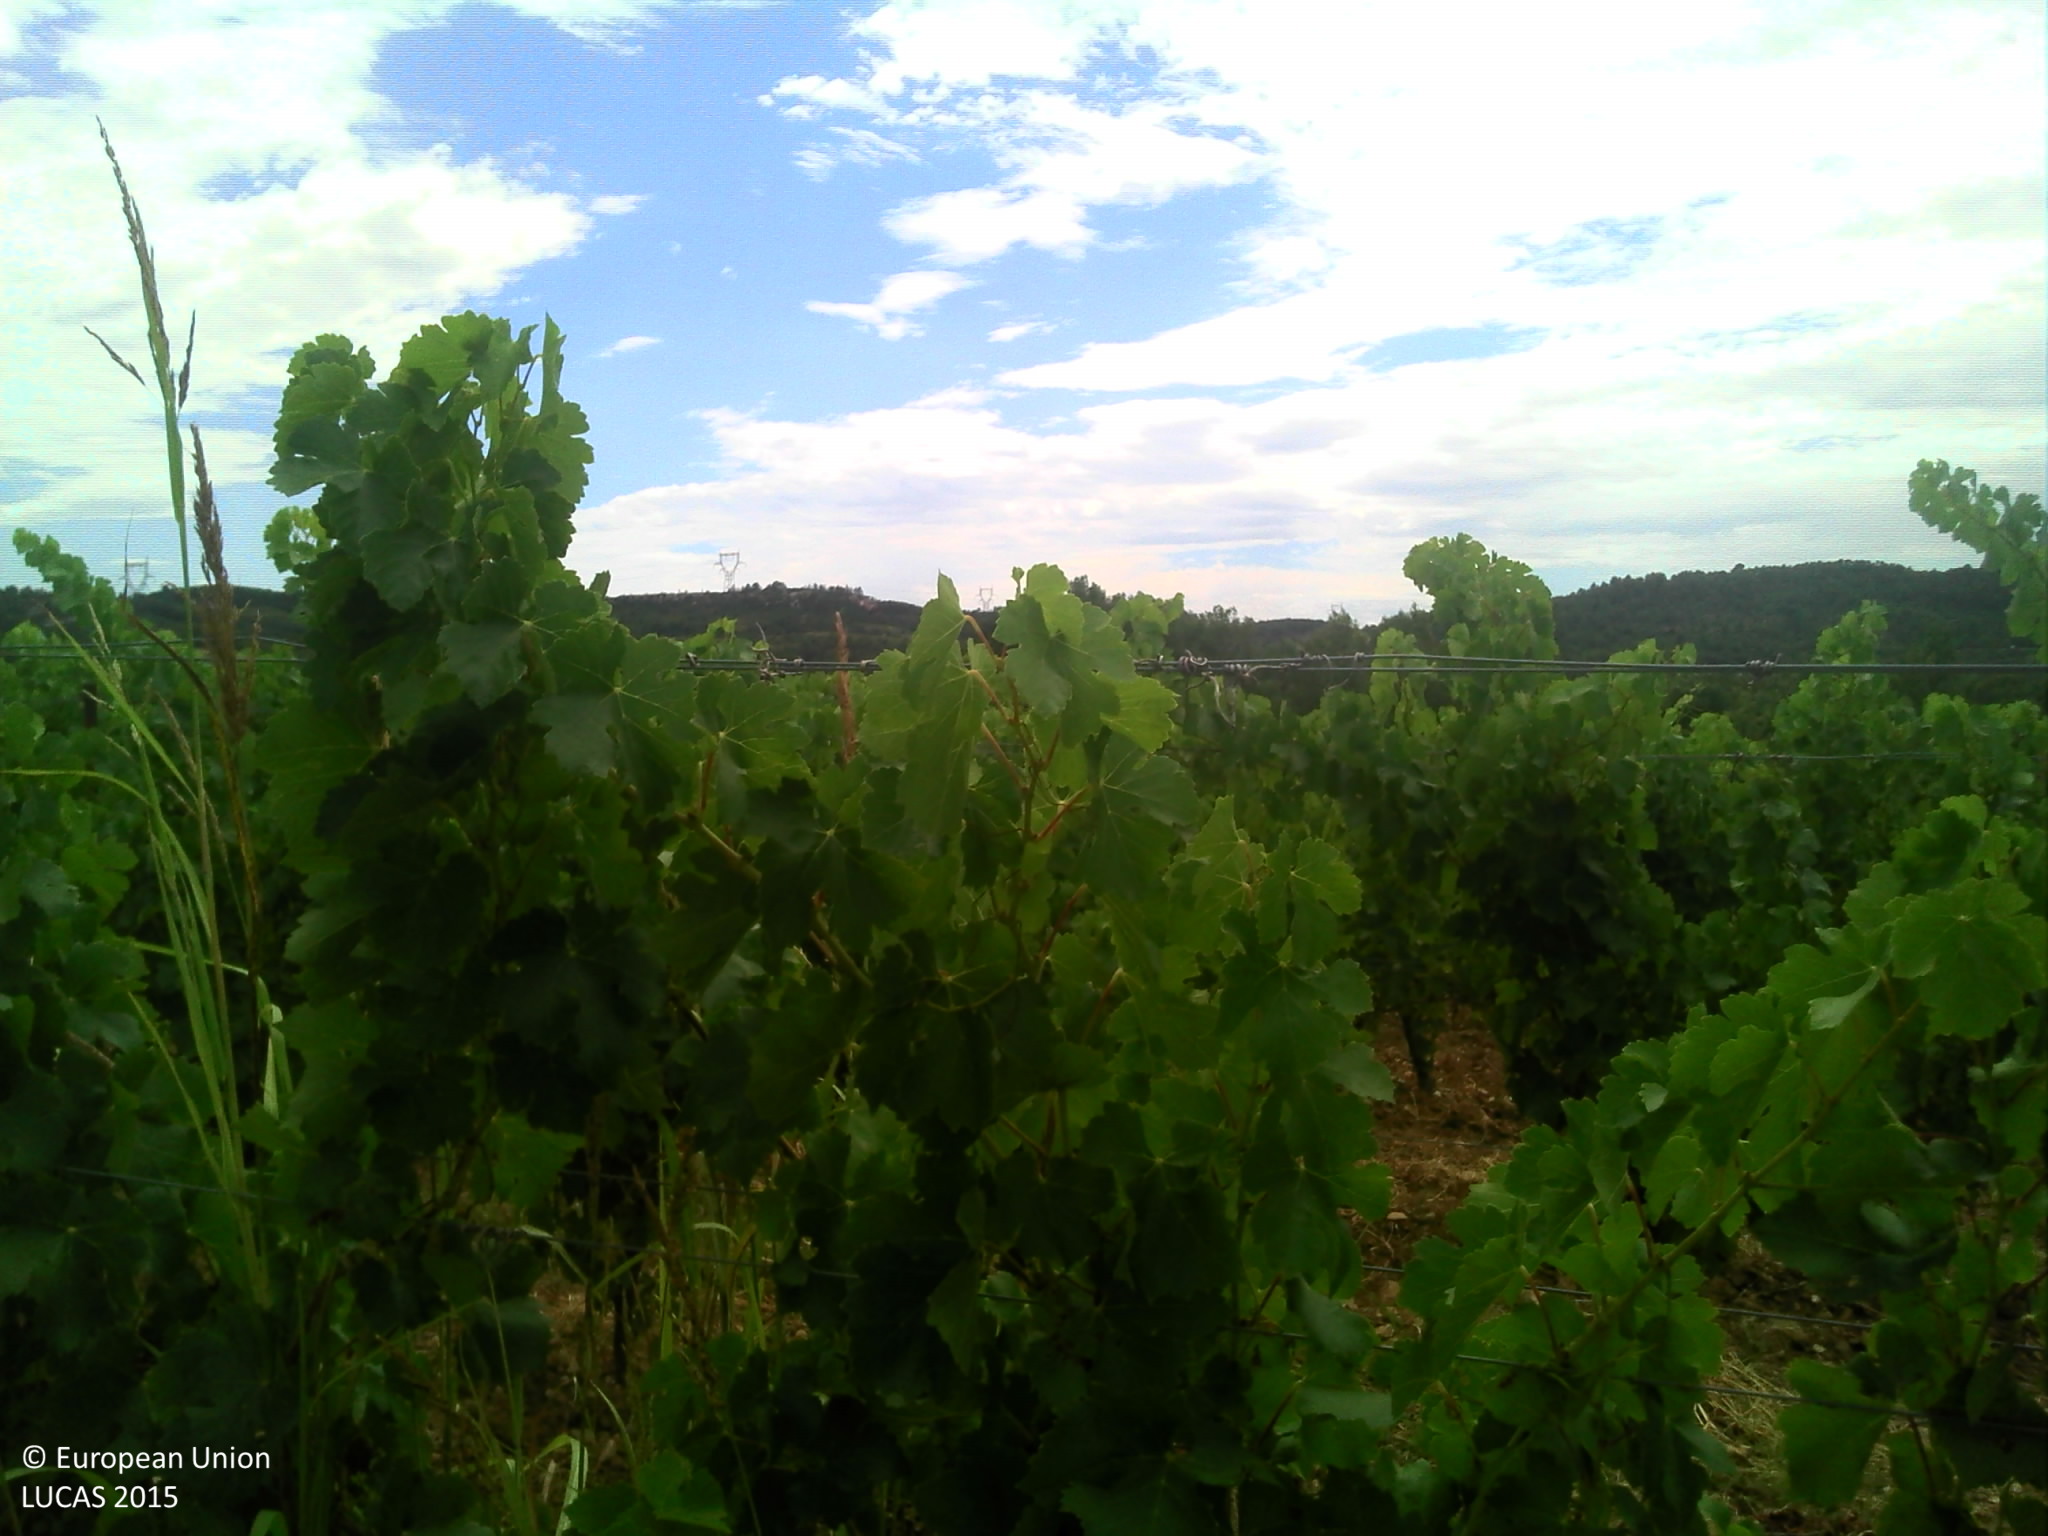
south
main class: Cropland
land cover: Vineyards
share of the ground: 25 - 50 %
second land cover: Other bare soil
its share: > 75 %
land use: Agriculture (excluding fallow land and kitchen gardens)
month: July
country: FR
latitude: 43.4494
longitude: 3.0763
